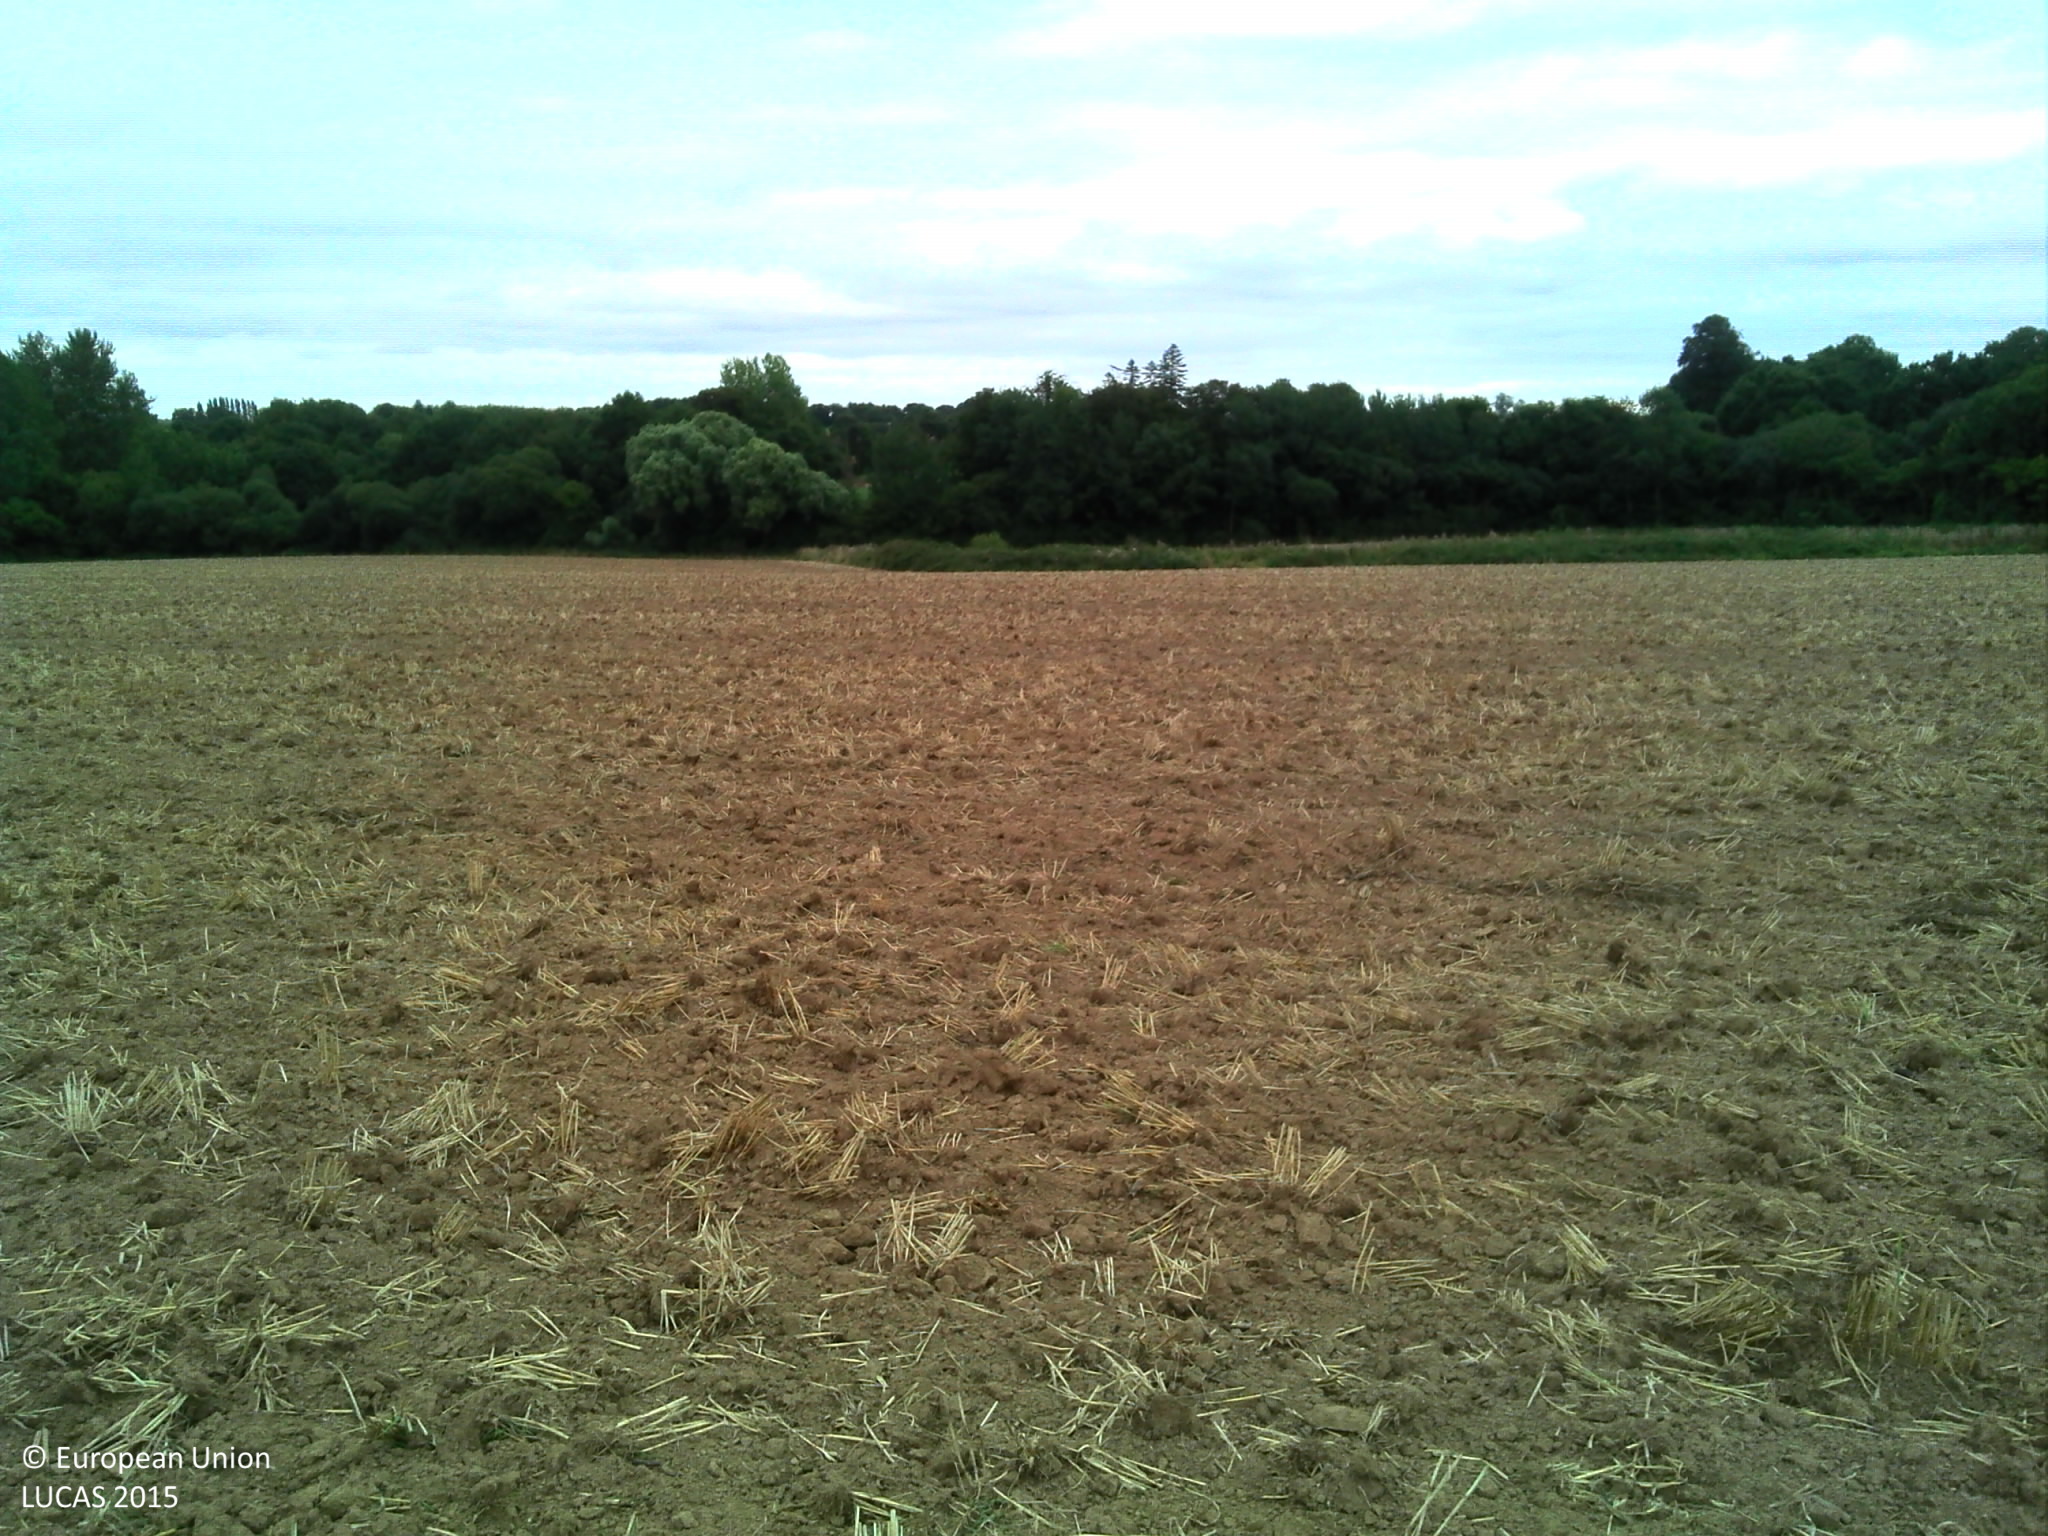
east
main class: Cropland
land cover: Common wheat
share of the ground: > 75 %
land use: Agriculture (excluding fallow land and kitchen gardens)
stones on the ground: < 10 %
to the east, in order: Common wheat; Broadleaved woodland; Grassland without tree/shrub cover
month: August
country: FR
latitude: 48.6679
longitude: -3.1771
